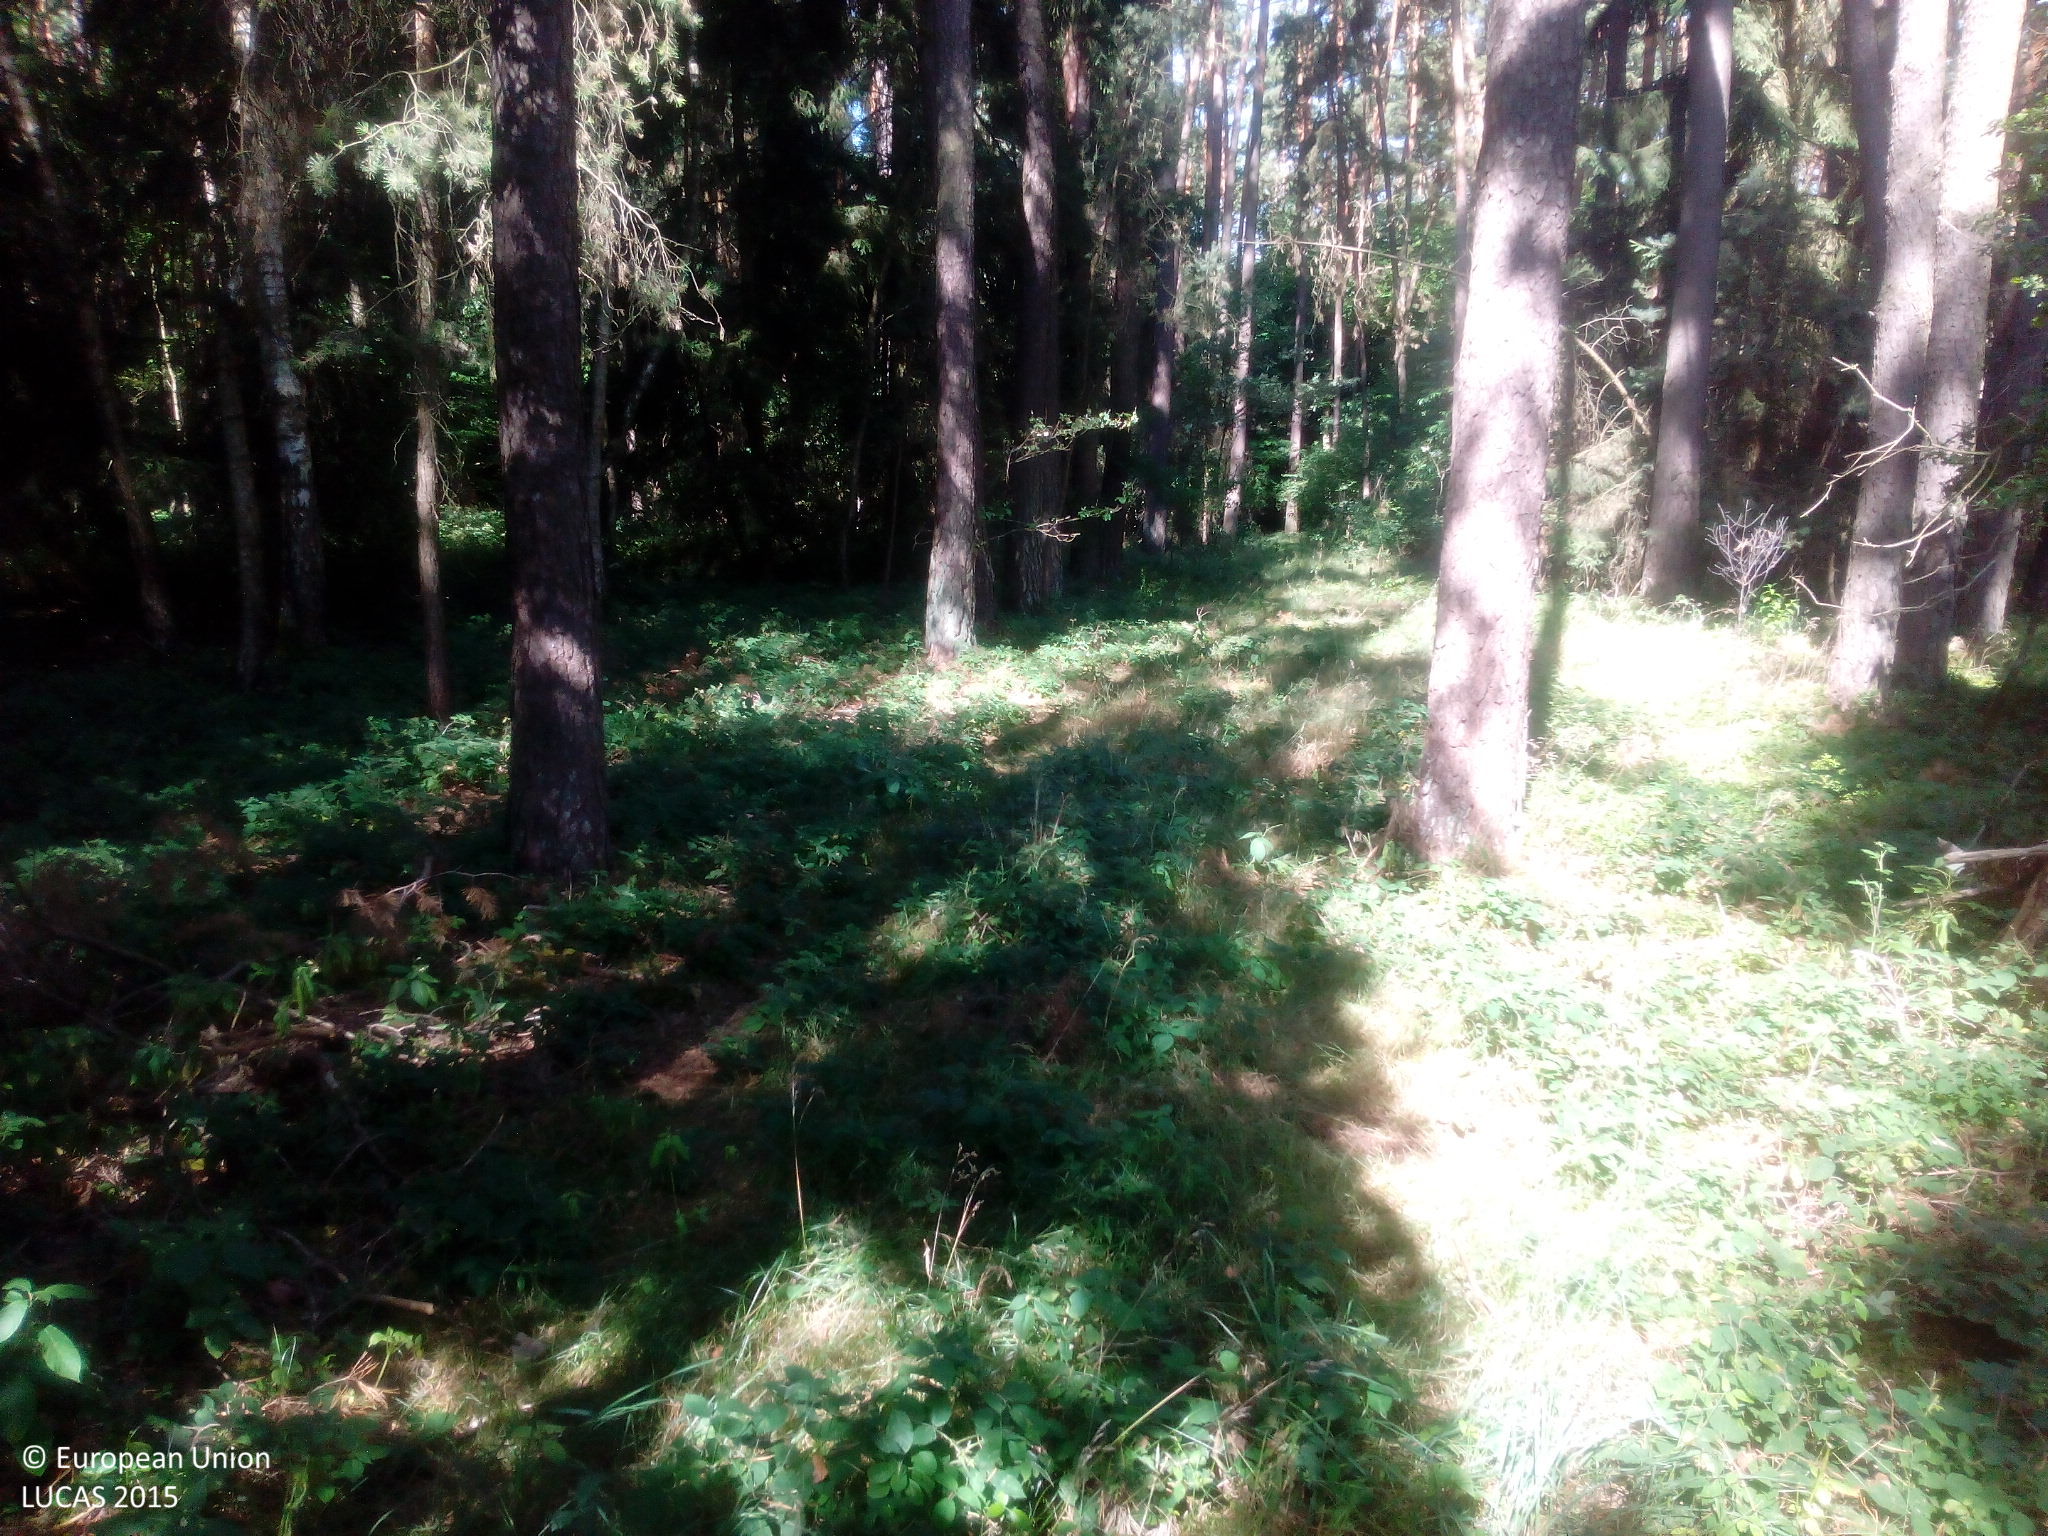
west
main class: Woodland
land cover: Other mixed woodland
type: hemiboreal forest and nemoral coniferous forest and mixed broadleaved-coniferous forest
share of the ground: > 75 %
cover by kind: coniferous forest trees 60 %, broadleaved forest trees 25 %, herbaceous plants 15 %
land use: Forestry
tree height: > 5 m
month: July
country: DE
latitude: 49.3352
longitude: 10.9217
